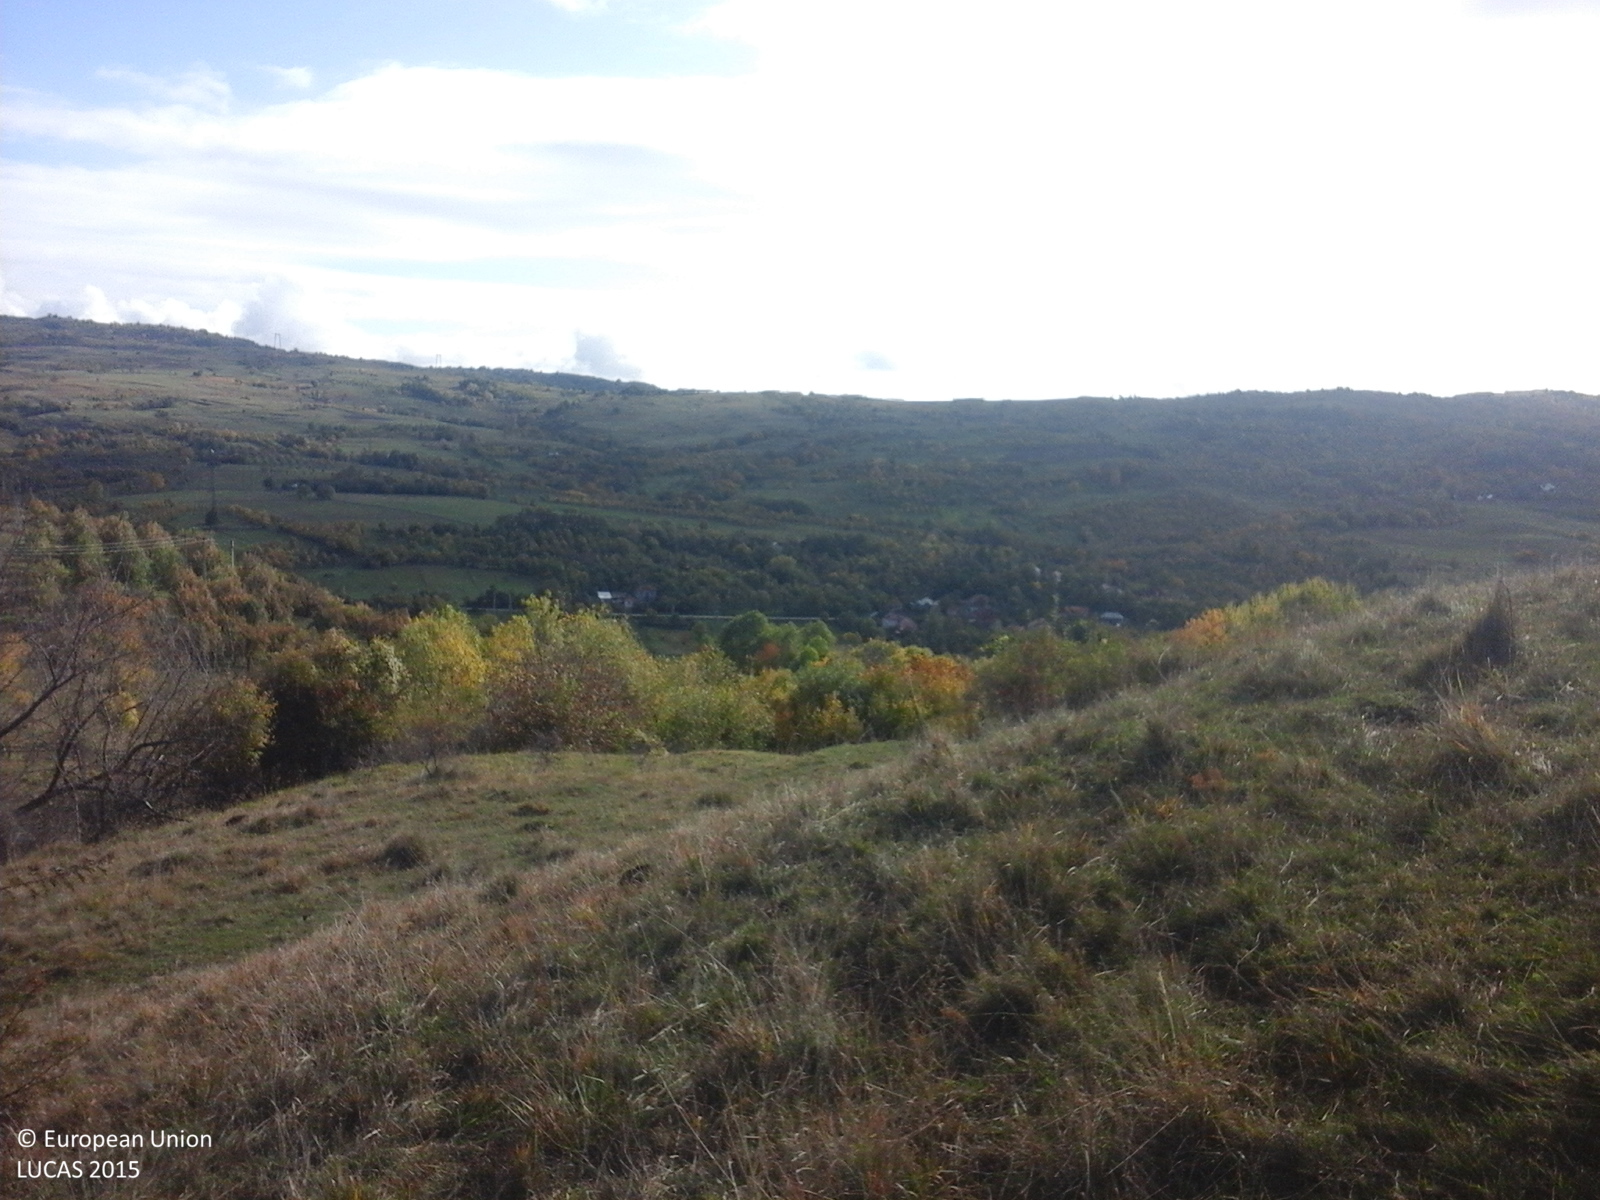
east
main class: Grassland
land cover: Grassland without tree/shrub cover
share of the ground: > 75 %
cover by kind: herbaceous plants 100 %
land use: Agriculture (excluding fallow land and kitchen gardens)
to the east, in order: Grassland without tree/shrub cover; Shrubland without tree cover; Rivers and streams; Shrubland without tree cover; Fences; Shrubland without tree cover; Grassland without tree/shrub cover; Tracks; Grassland without tree/shrub cover; Tracks; Grassland with sparse tree/shrub cover; Apple fruit
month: October
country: RO
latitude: 45.1949
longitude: 25.1229
